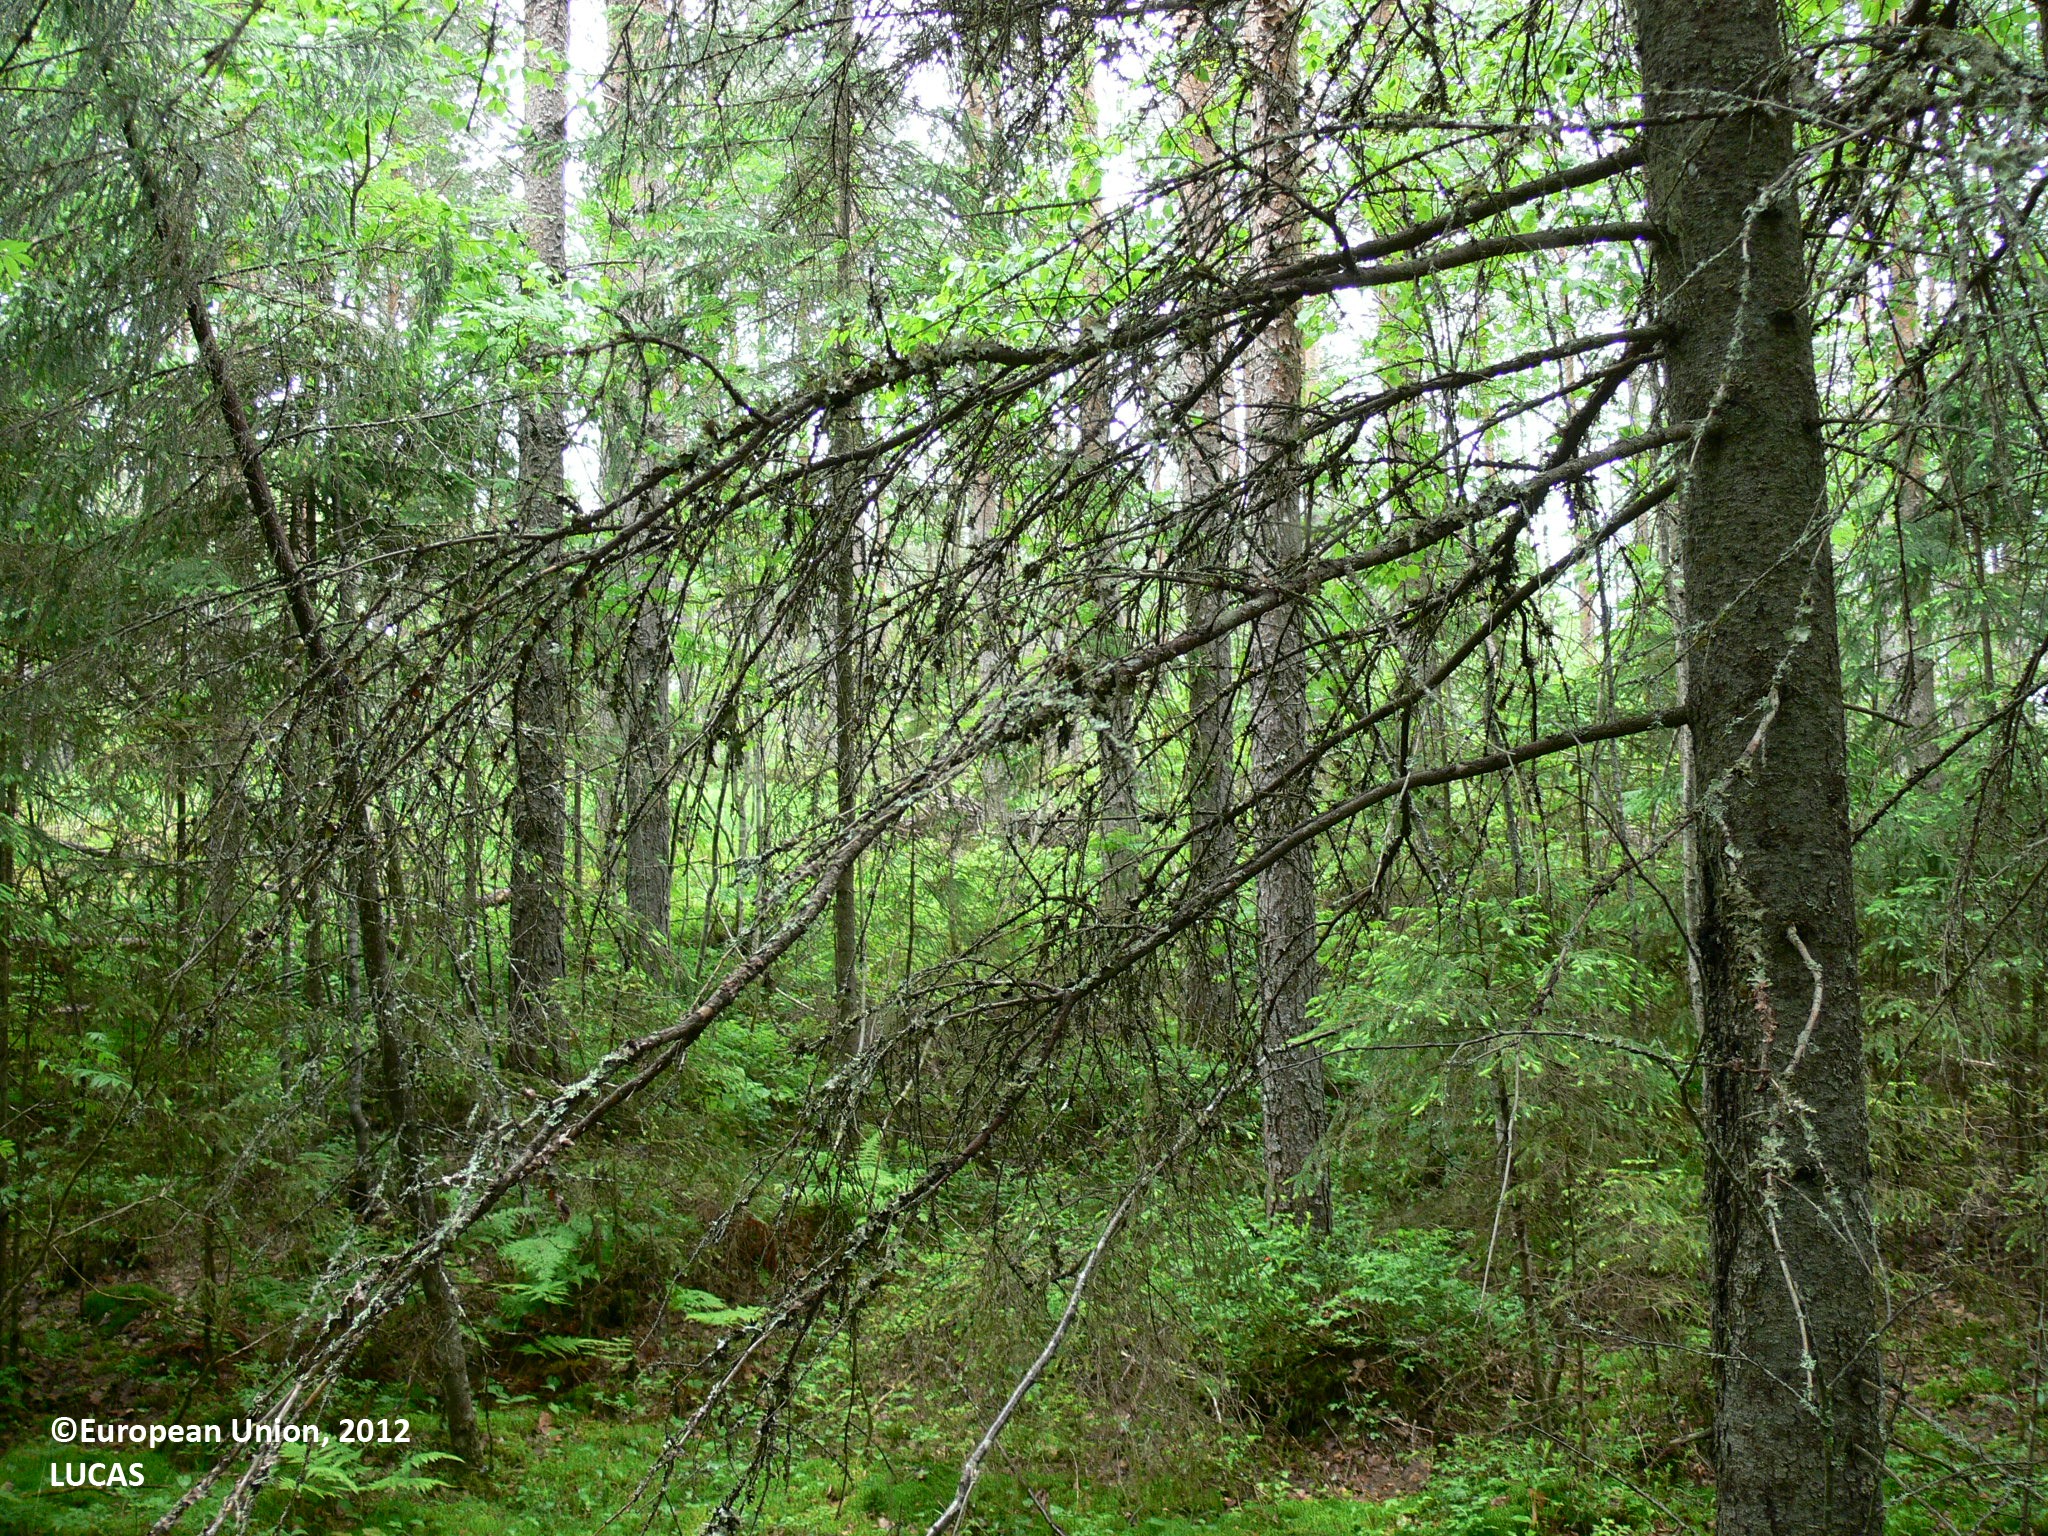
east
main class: Woodland
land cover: Spruce dominated coniferous woodland
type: boreal forest
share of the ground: > 75 %
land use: Forestry
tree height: > 5 m
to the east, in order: Spruce dominated coniferous woodland; Pine dominated coniferous woodland; Grassland with sparse tree/shrub cover; Electric lines; Grassland with sparse tree/shrub cover; Pine dominated coniferous woodland; Electric lines; Pine dominated coniferous woodland; Ditches and canals; Shruby margins; Paved roads, cycling and walking lanes; Shruby margins; Ditches and canals; Pine dominated coniferous woodland; Other mixed woodland; Ditches and canals; Spruce dominated coniferous woodland; Ditches and canals; Spruce dominated coniferous woodland; Spruce dominated mixed woodland
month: June
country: FI
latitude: 62.8603
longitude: 29.8402
